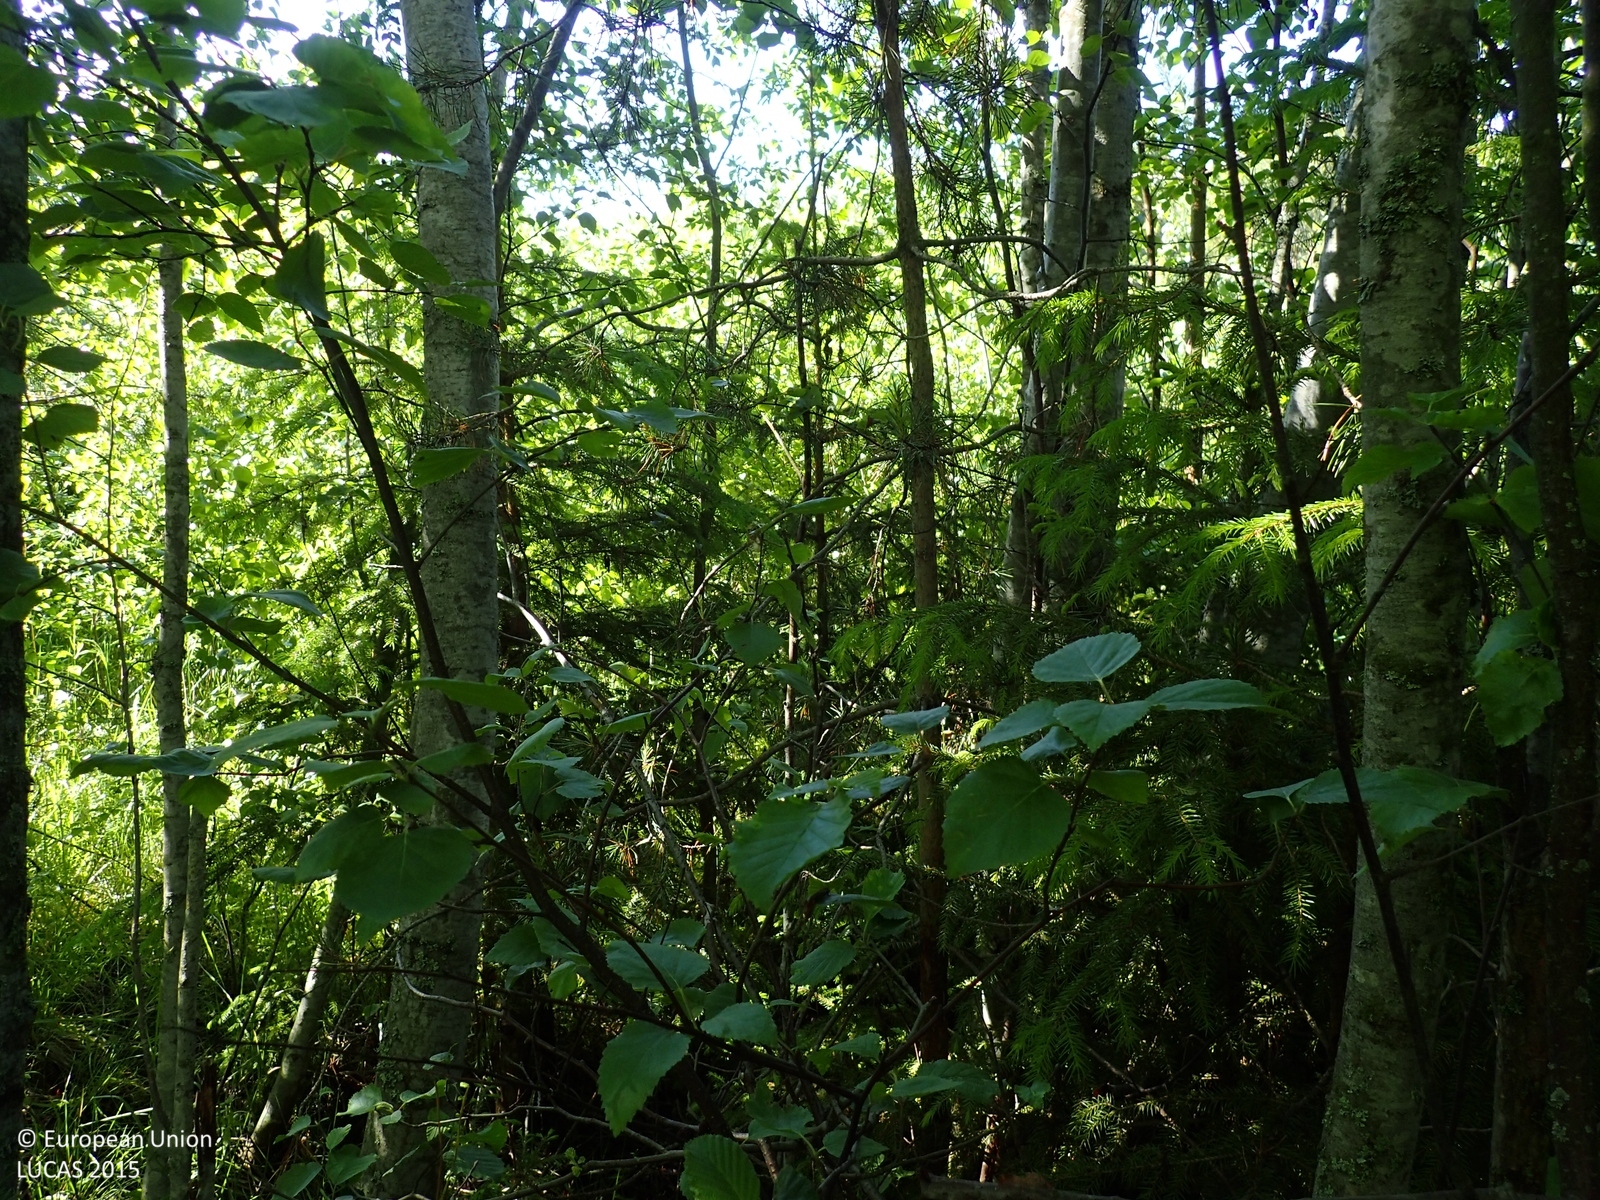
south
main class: Woodland
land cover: Broadleaved woodland
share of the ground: > 75 %
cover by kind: broadleaved forest trees 75 %, herbaceous plants 25 %
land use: Forestry
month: June
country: FI
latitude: 62.2848
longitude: 21.4351
